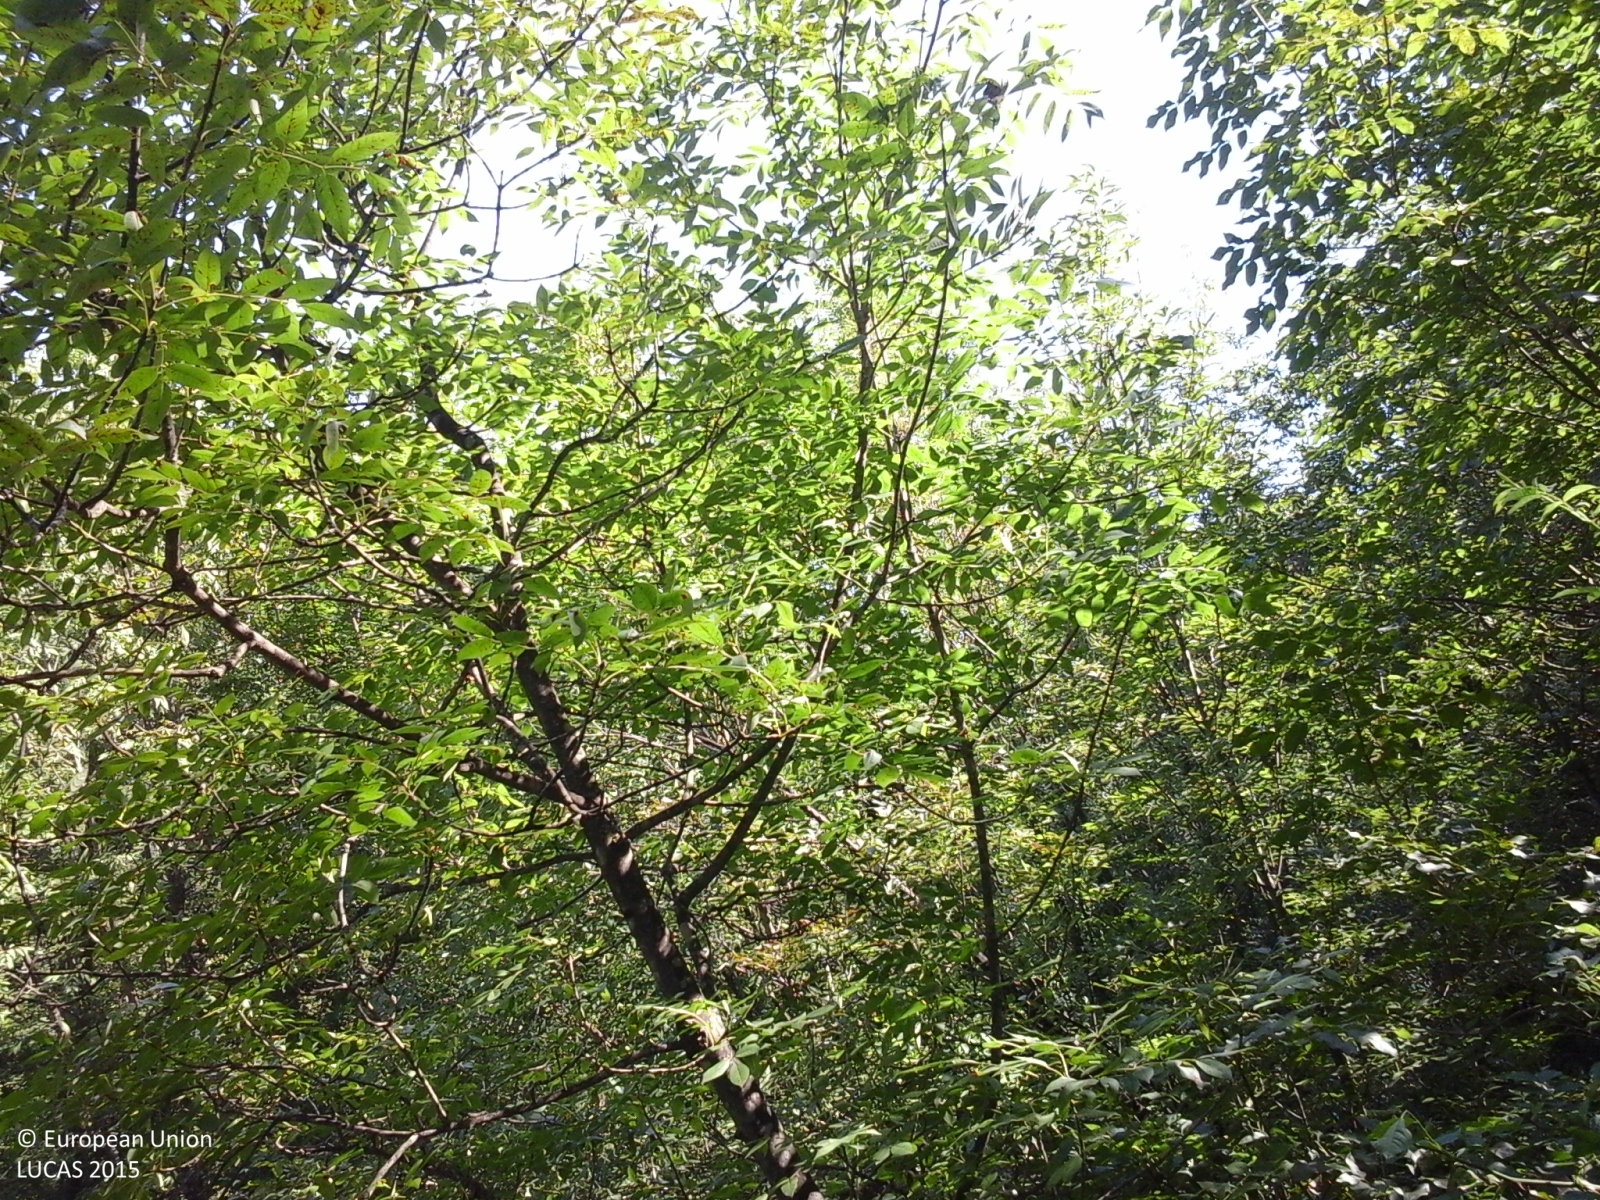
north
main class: Woodland
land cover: Broadleaved woodland
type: thermophilous deciduous forest
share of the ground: > 75 %
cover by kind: broadleaved forest trees 85 %, herbaceous plants 10 %, shrubs 5 %
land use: Semi-natural and natural areas not in use
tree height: < 5 m
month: June
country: IT
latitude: 44.5175
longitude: 8.3303
